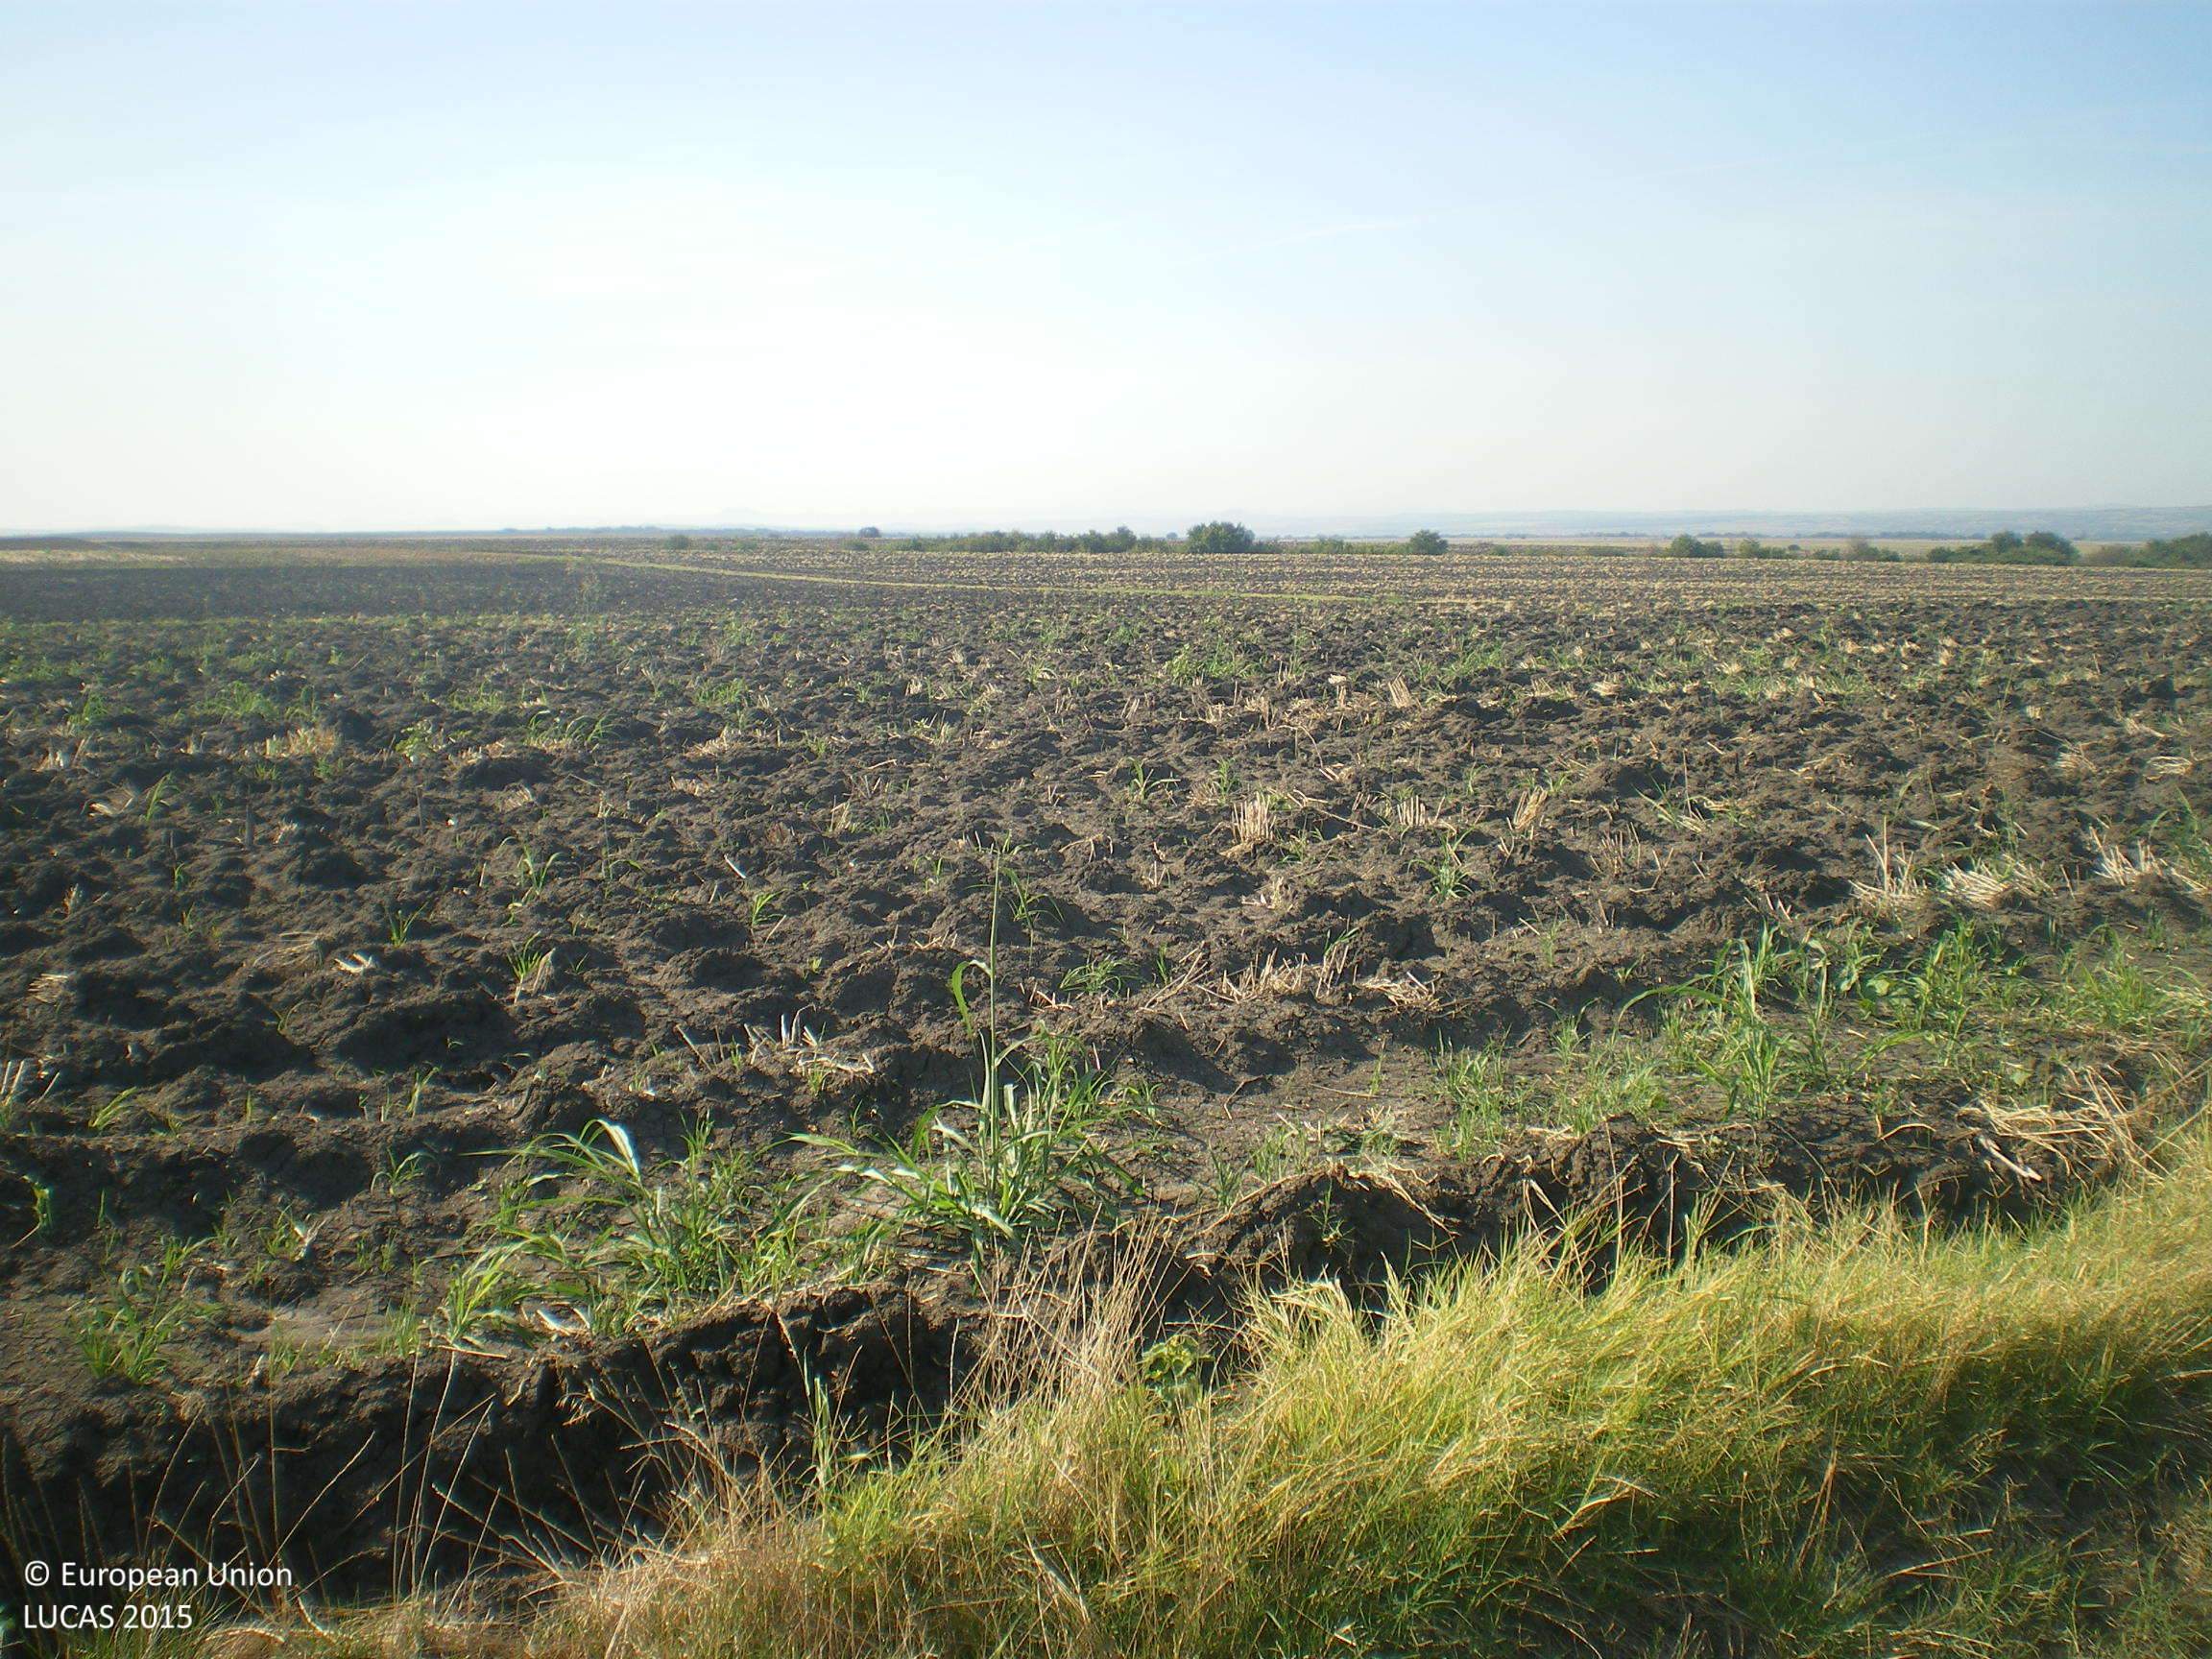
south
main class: Cropland
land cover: Sunflower
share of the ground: > 75 %
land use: Agriculture (excluding fallow land and kitchen gardens)
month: September
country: BG
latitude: 42.0871
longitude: 25.8983
